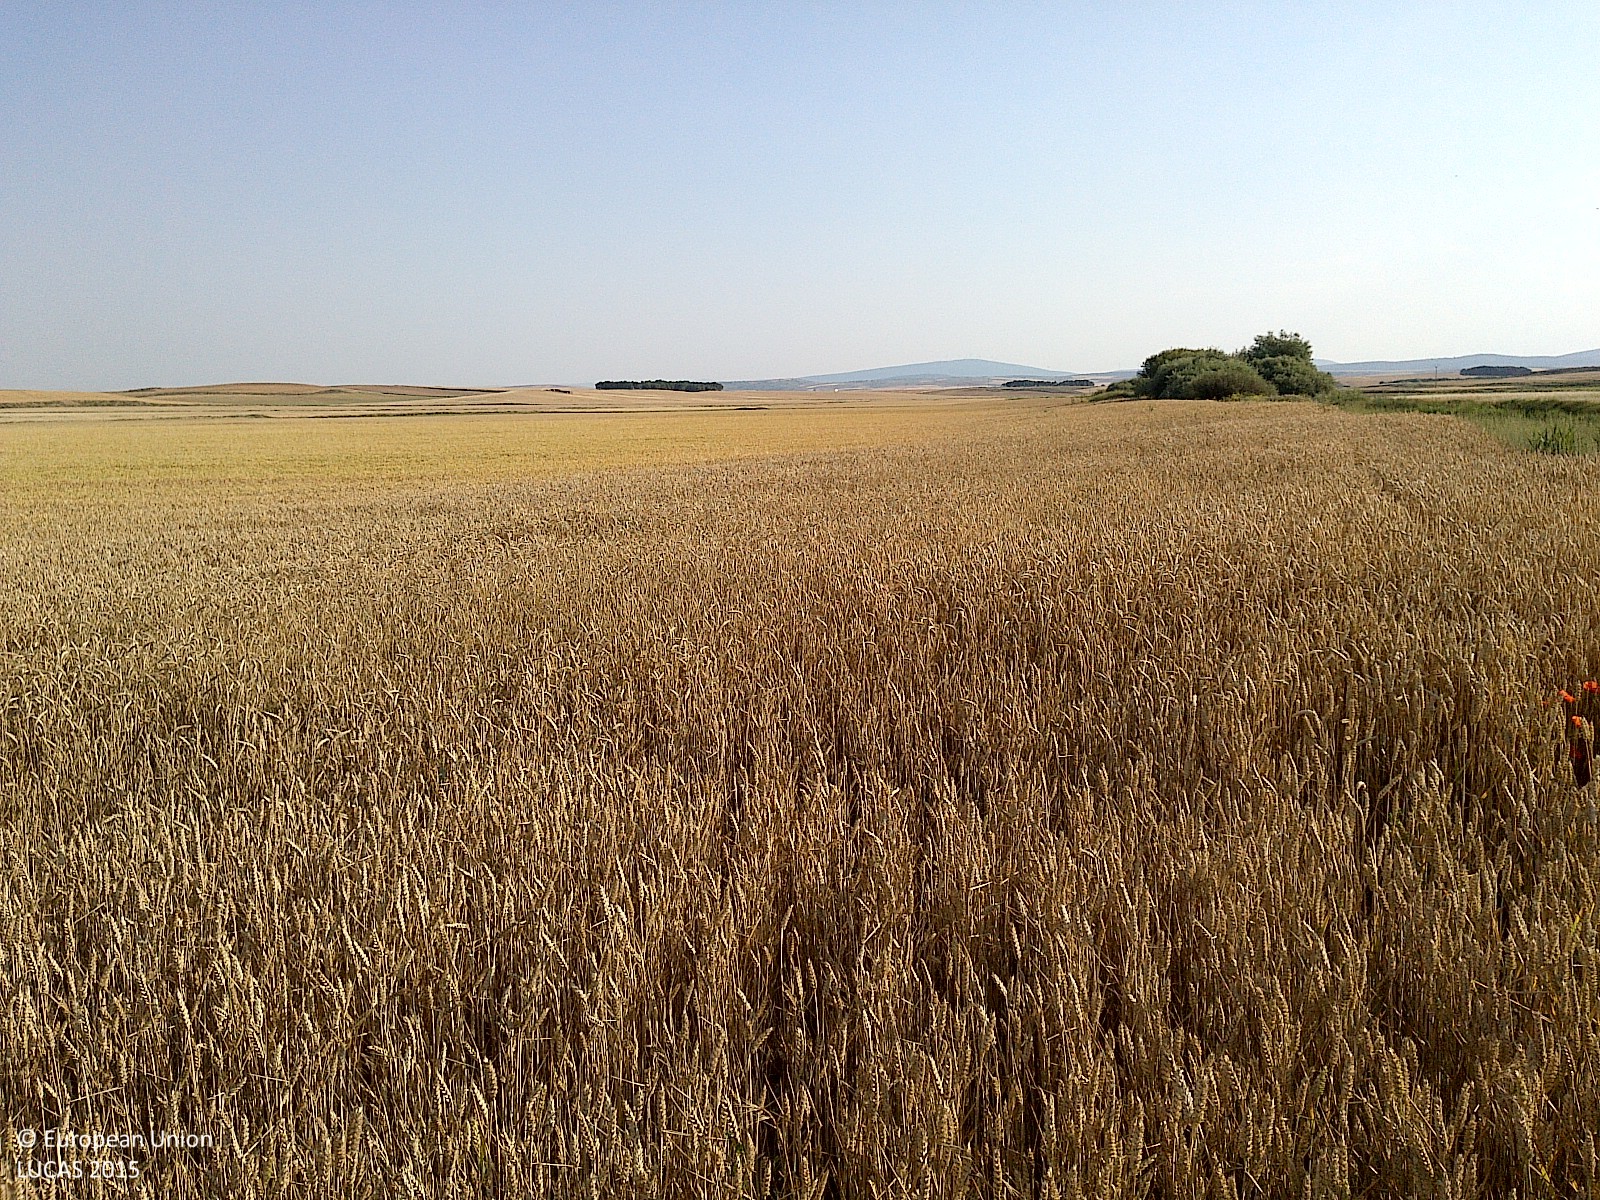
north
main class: Cropland
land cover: Common wheat
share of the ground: > 75 %
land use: Agriculture (excluding fallow land and kitchen gardens)
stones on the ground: < 10 %
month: June
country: ES
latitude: 41.6495
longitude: -2.2698
